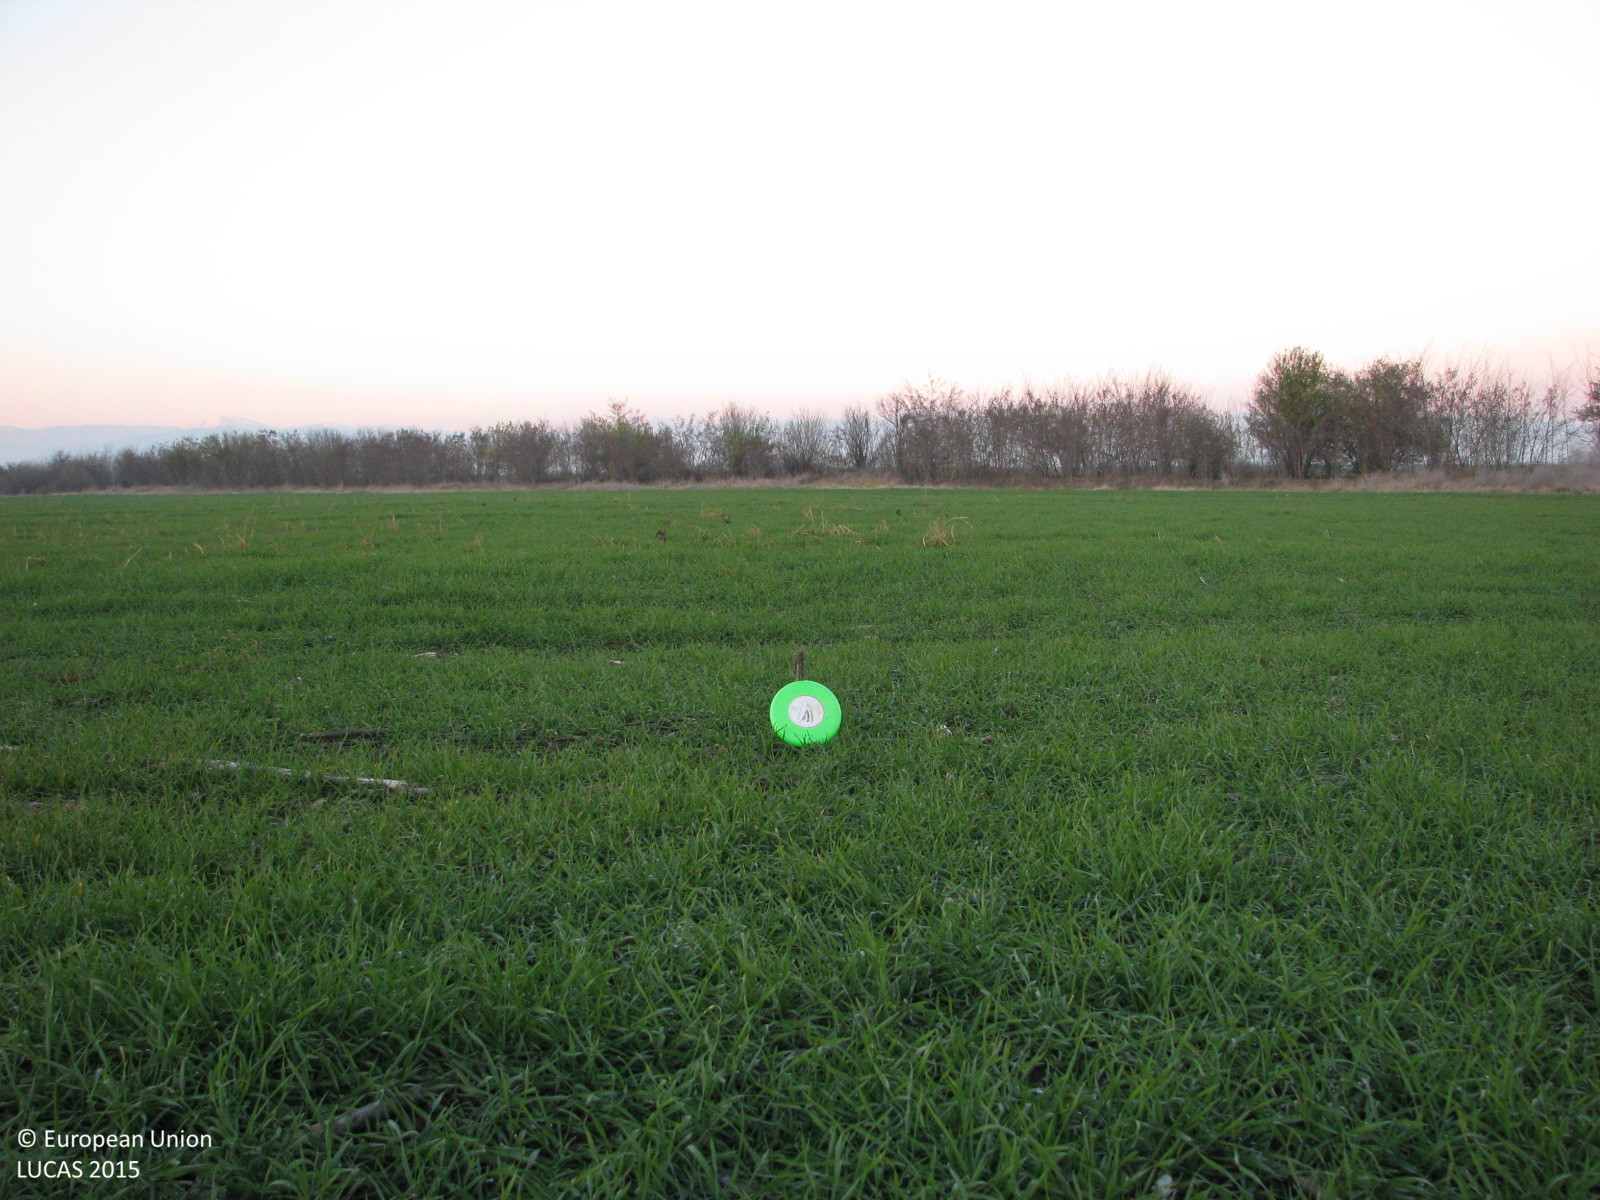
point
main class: Cropland
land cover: Common wheat
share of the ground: > 75 %
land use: Agriculture (excluding fallow land and kitchen gardens)
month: December
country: BG
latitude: 42.2978
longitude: 25.0138
